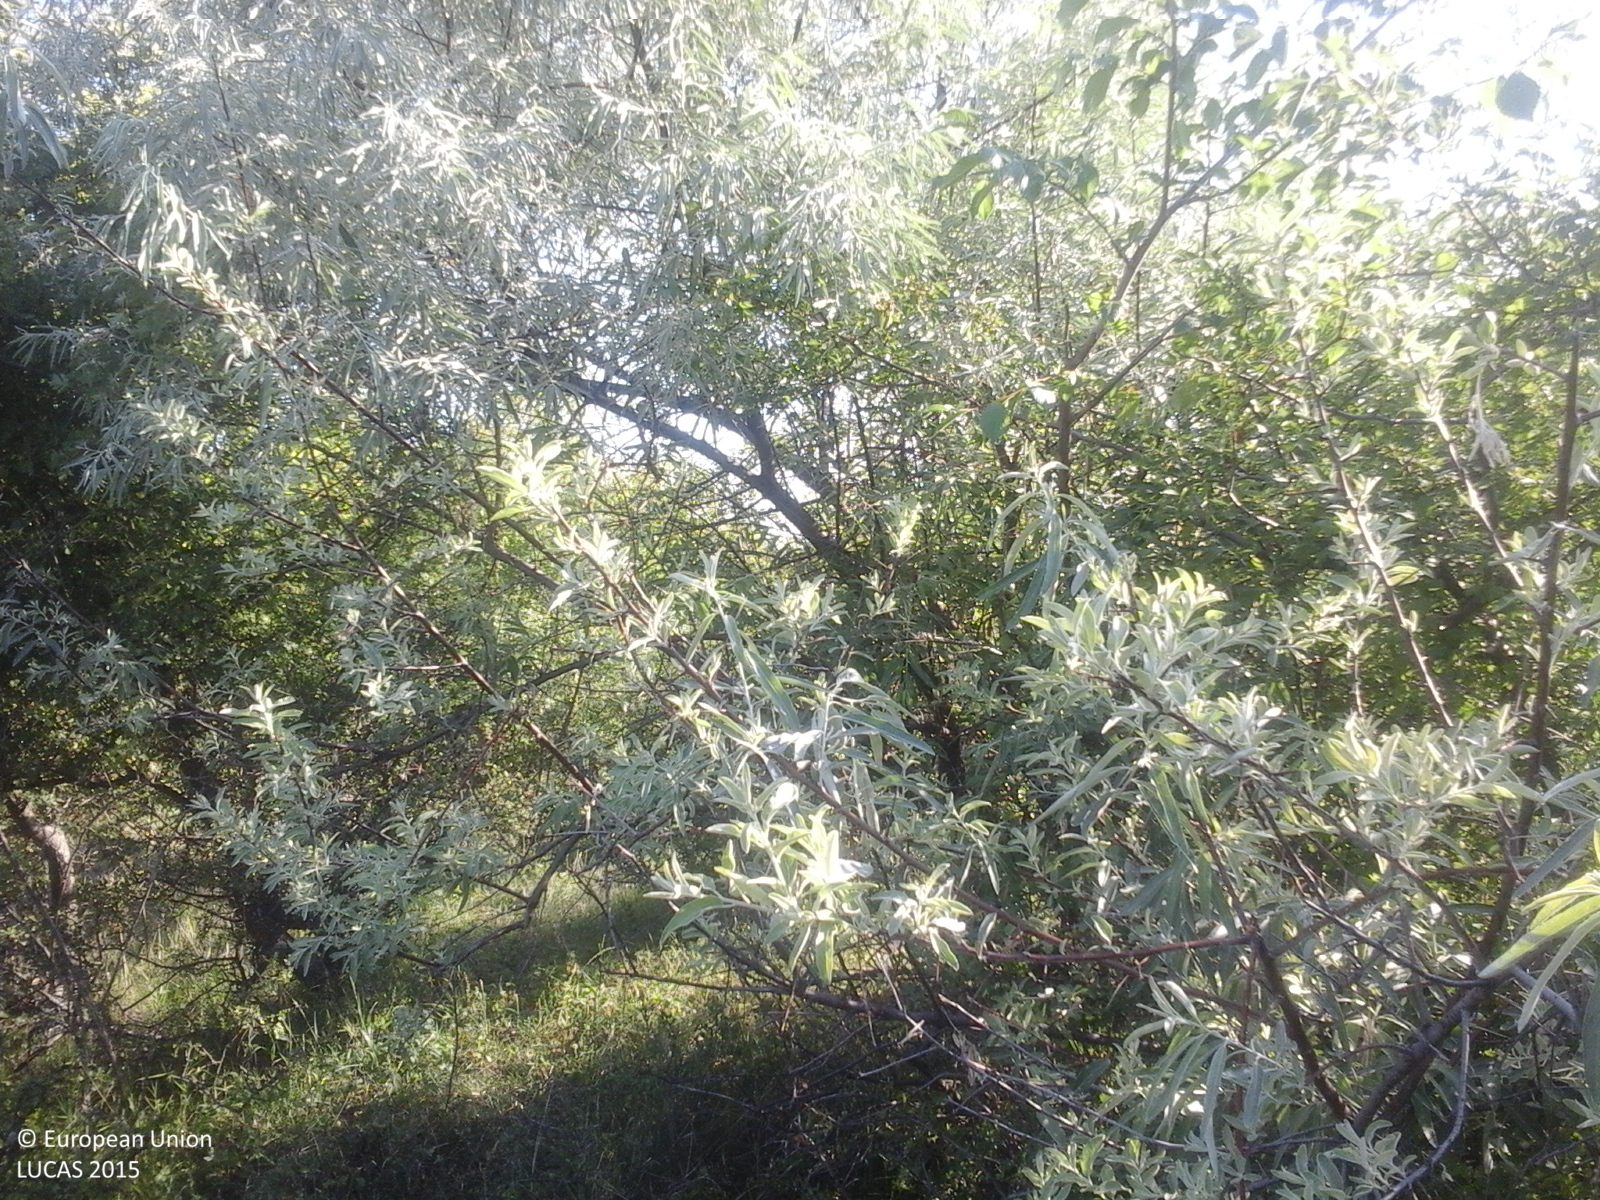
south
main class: Shrubland
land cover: Shrubland with sparse tree cover
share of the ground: > 75 %
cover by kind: herbaceous plants 85 %, shrubs 10 %, broadleaved forest trees 5 %
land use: Agriculture (excluding fallow land and kitchen gardens)
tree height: < 5 m
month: June
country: RO
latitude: 46.9990
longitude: 27.3509
